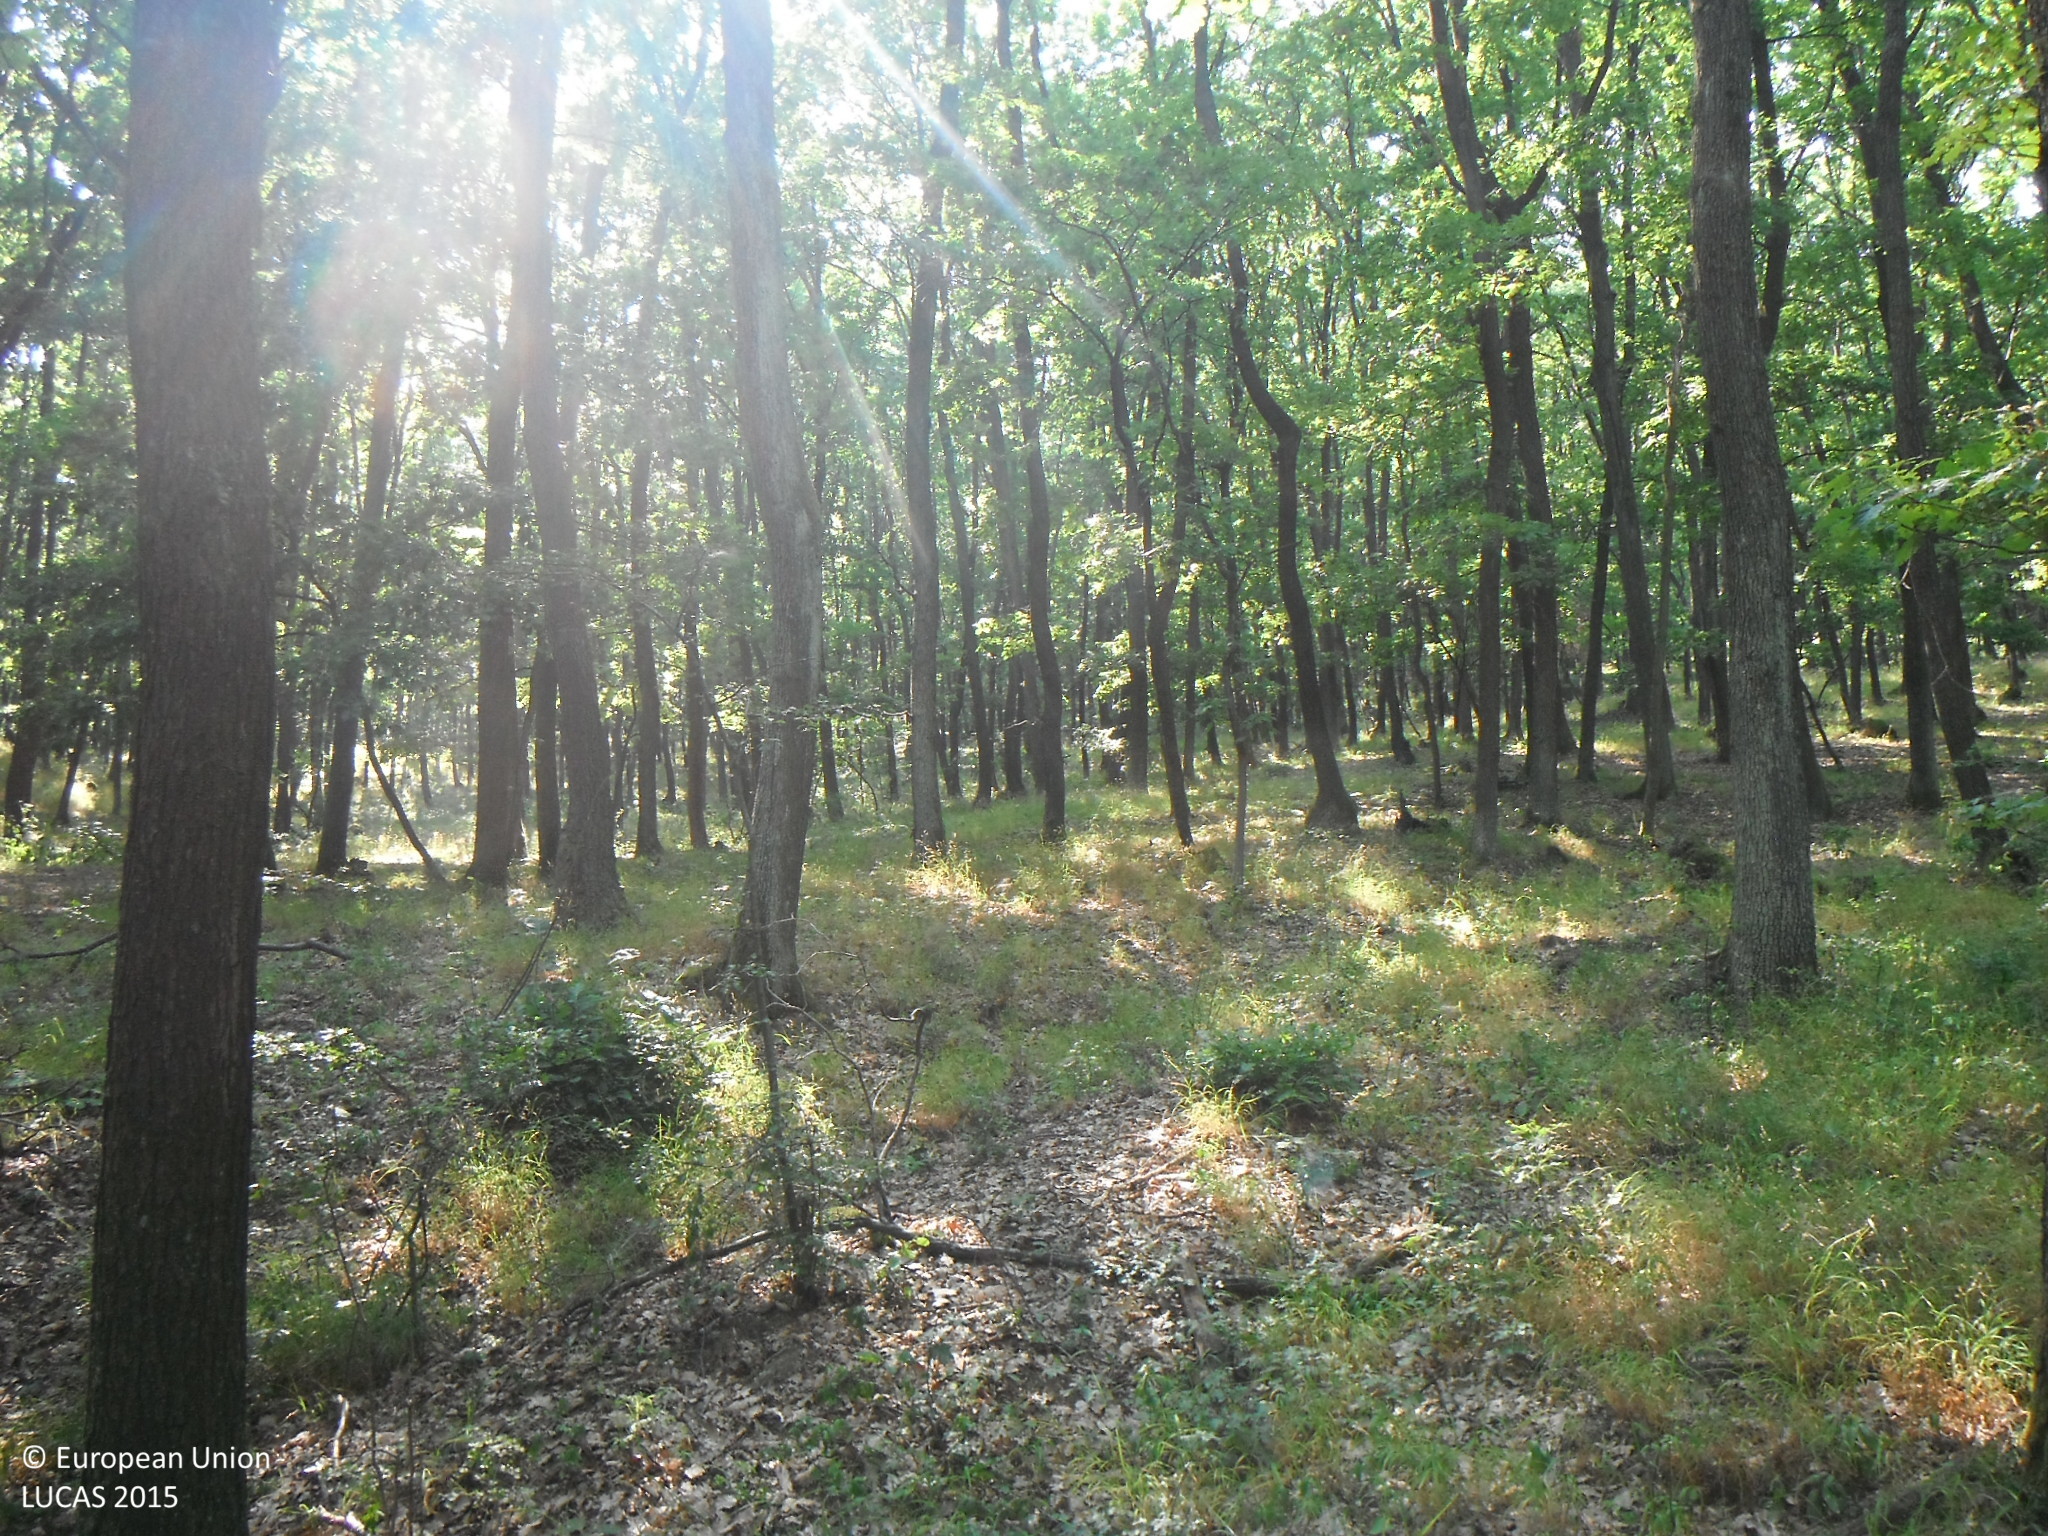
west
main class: Woodland
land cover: Broadleaved woodland
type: acidophilous oak and oak-birch forest
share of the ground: > 75 %
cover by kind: broadleaved forest trees 85 %, herbaceous plants 10 %, shrubs 5 %
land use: Forestry
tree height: > 5 m
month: July
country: SK
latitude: 48.1504
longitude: 19.1477
